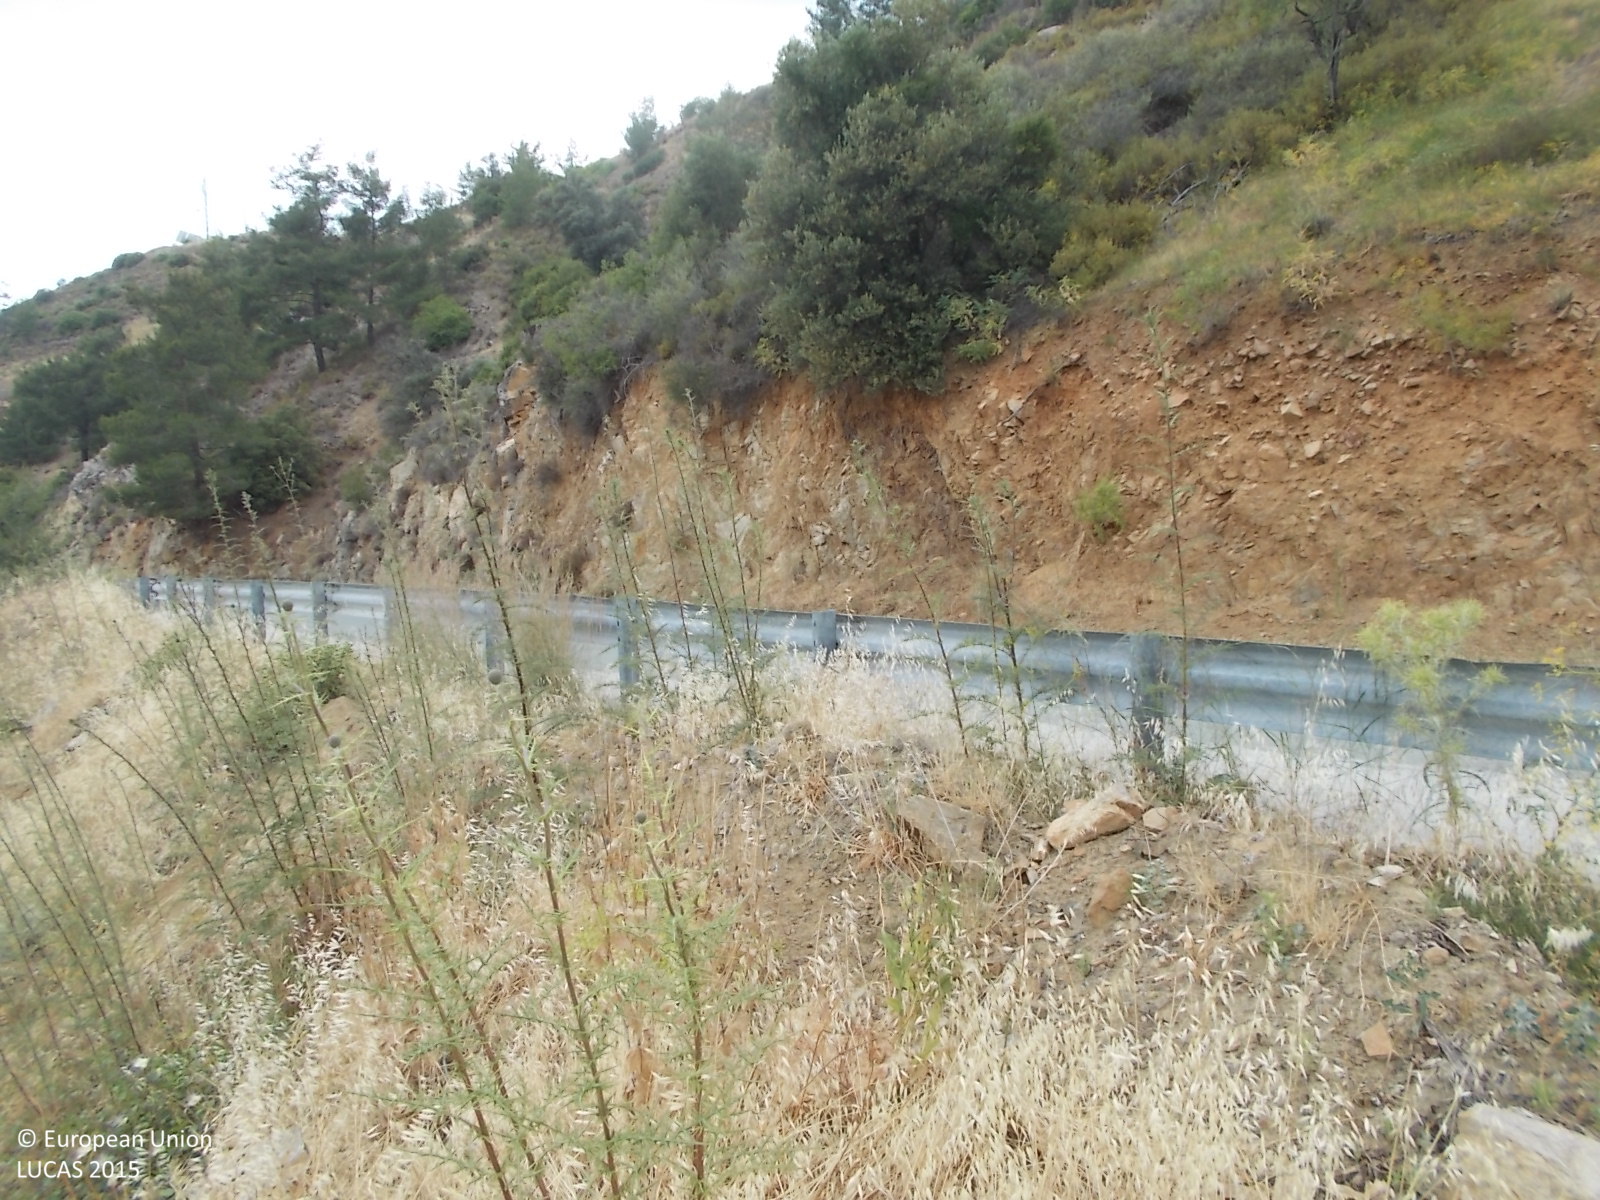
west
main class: Woodland
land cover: Pine dominated coniferous woodland
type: coniferous forest of the mediterranean region
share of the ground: 10 - 25 %
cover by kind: shrubs 35 %, coniferous forest trees 25 %, unconsolidated bare surface 25 %, herbaceous plants 15 %
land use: Forestry
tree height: > 5 m
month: June
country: CY
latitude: 34.9225
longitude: 32.7895
